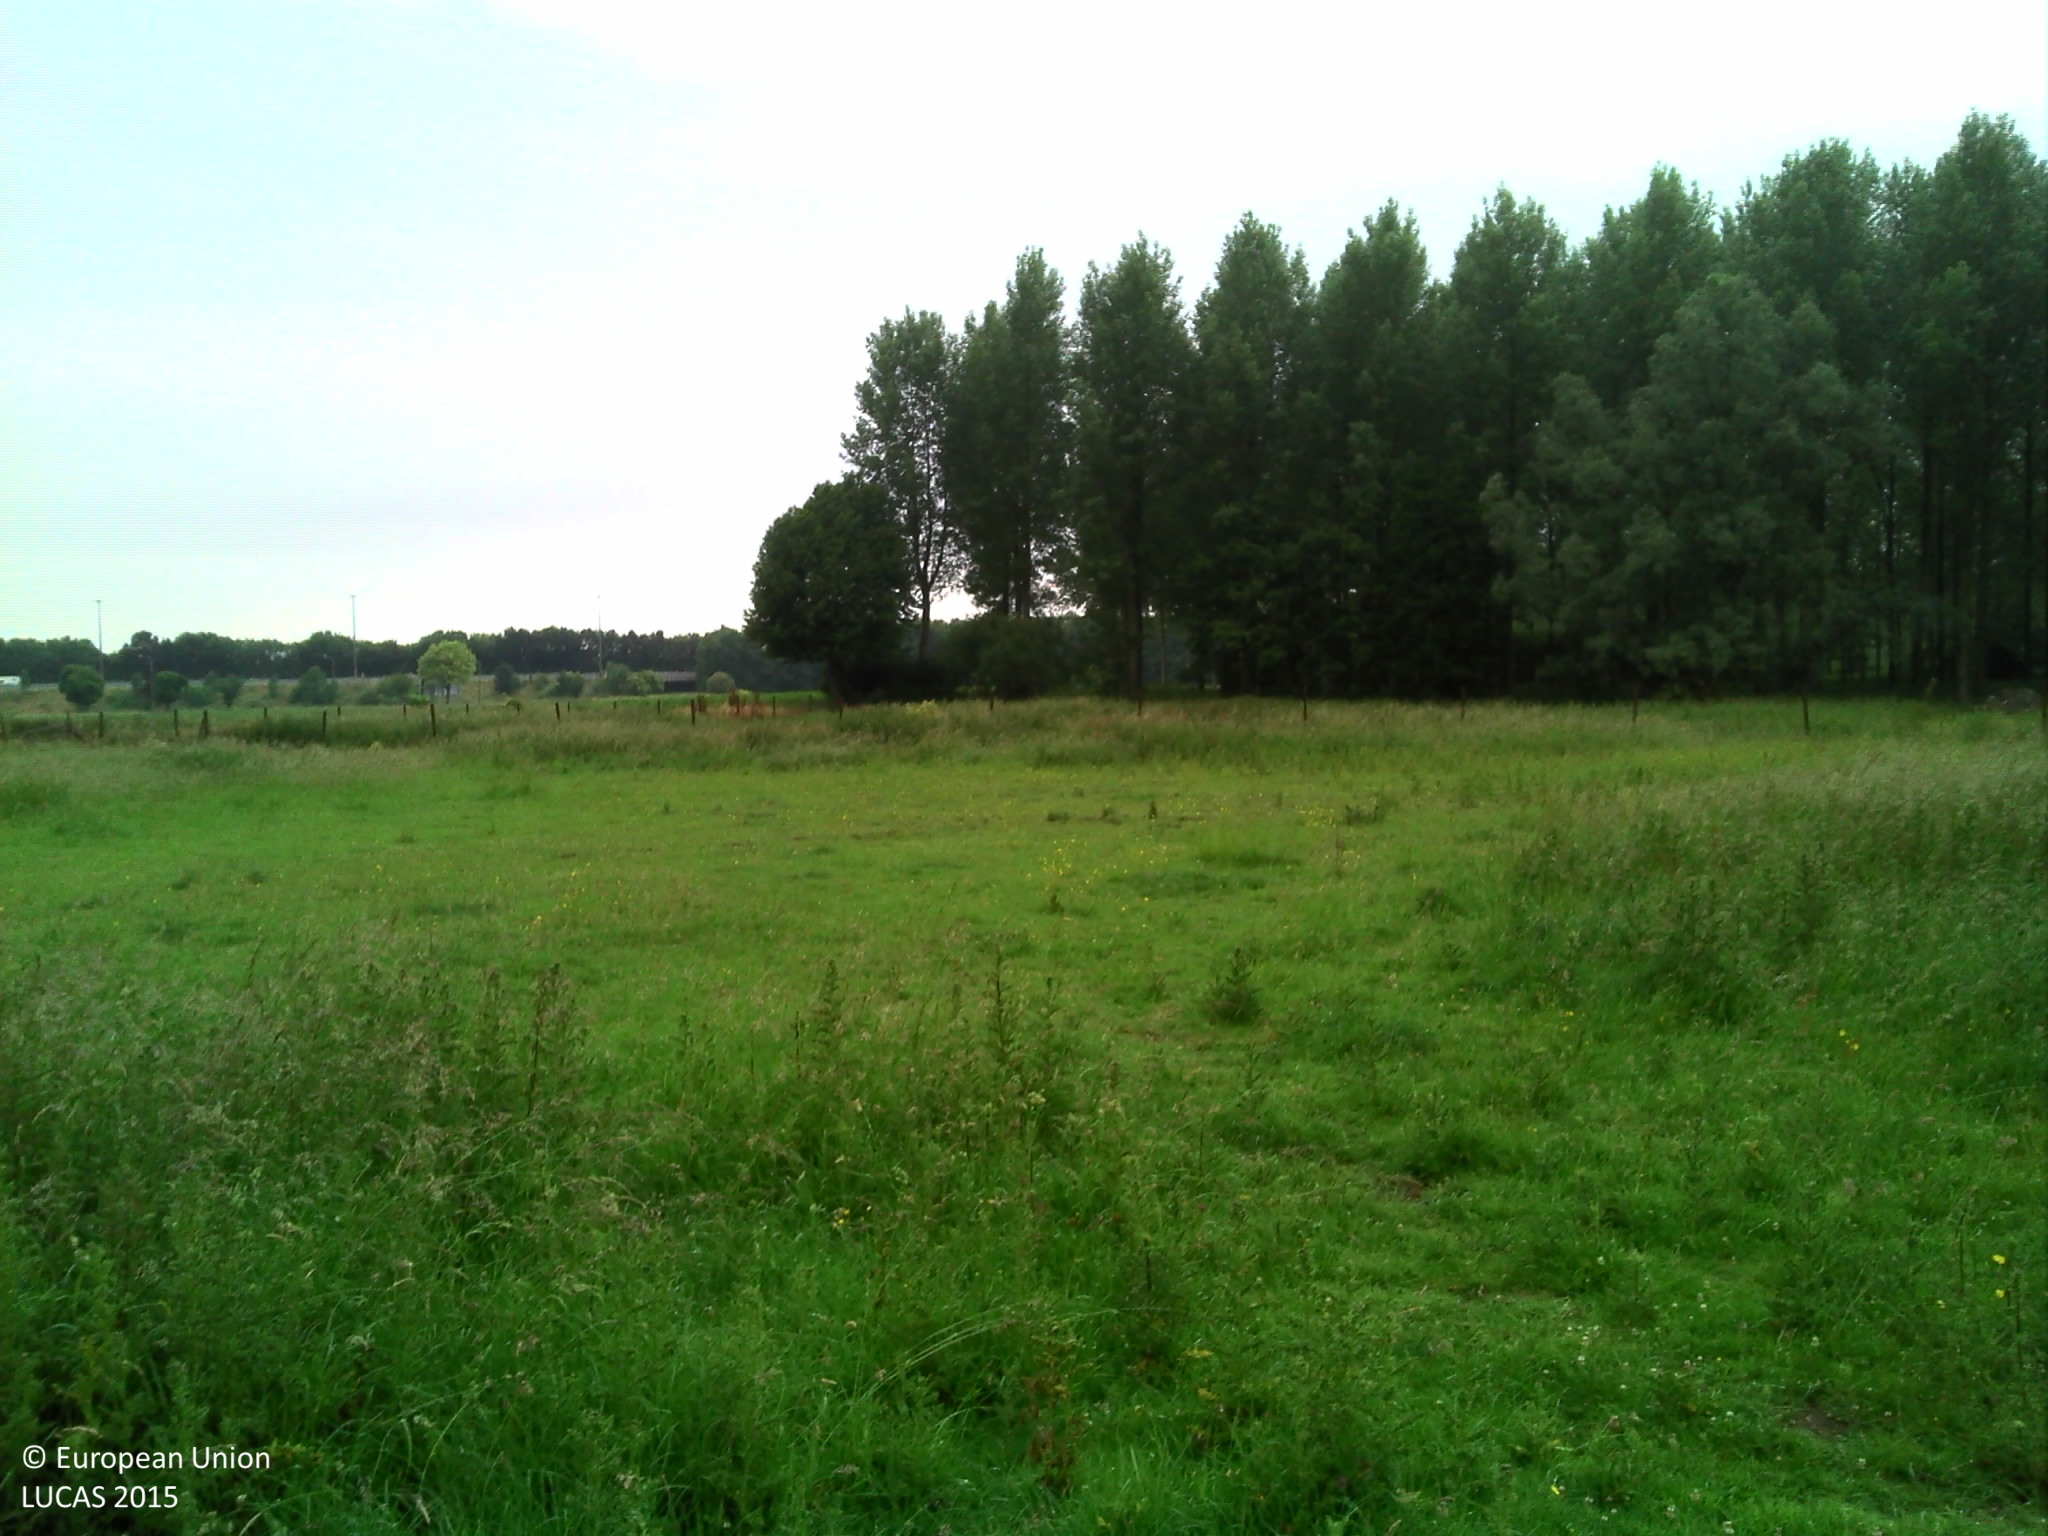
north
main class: Grassland
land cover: Grassland without tree/shrub cover
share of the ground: > 75 %
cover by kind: herbaceous plants 100 %
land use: Agriculture (excluding fallow land and kitchen gardens)
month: June
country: BE
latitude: 50.4428
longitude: 3.6988
